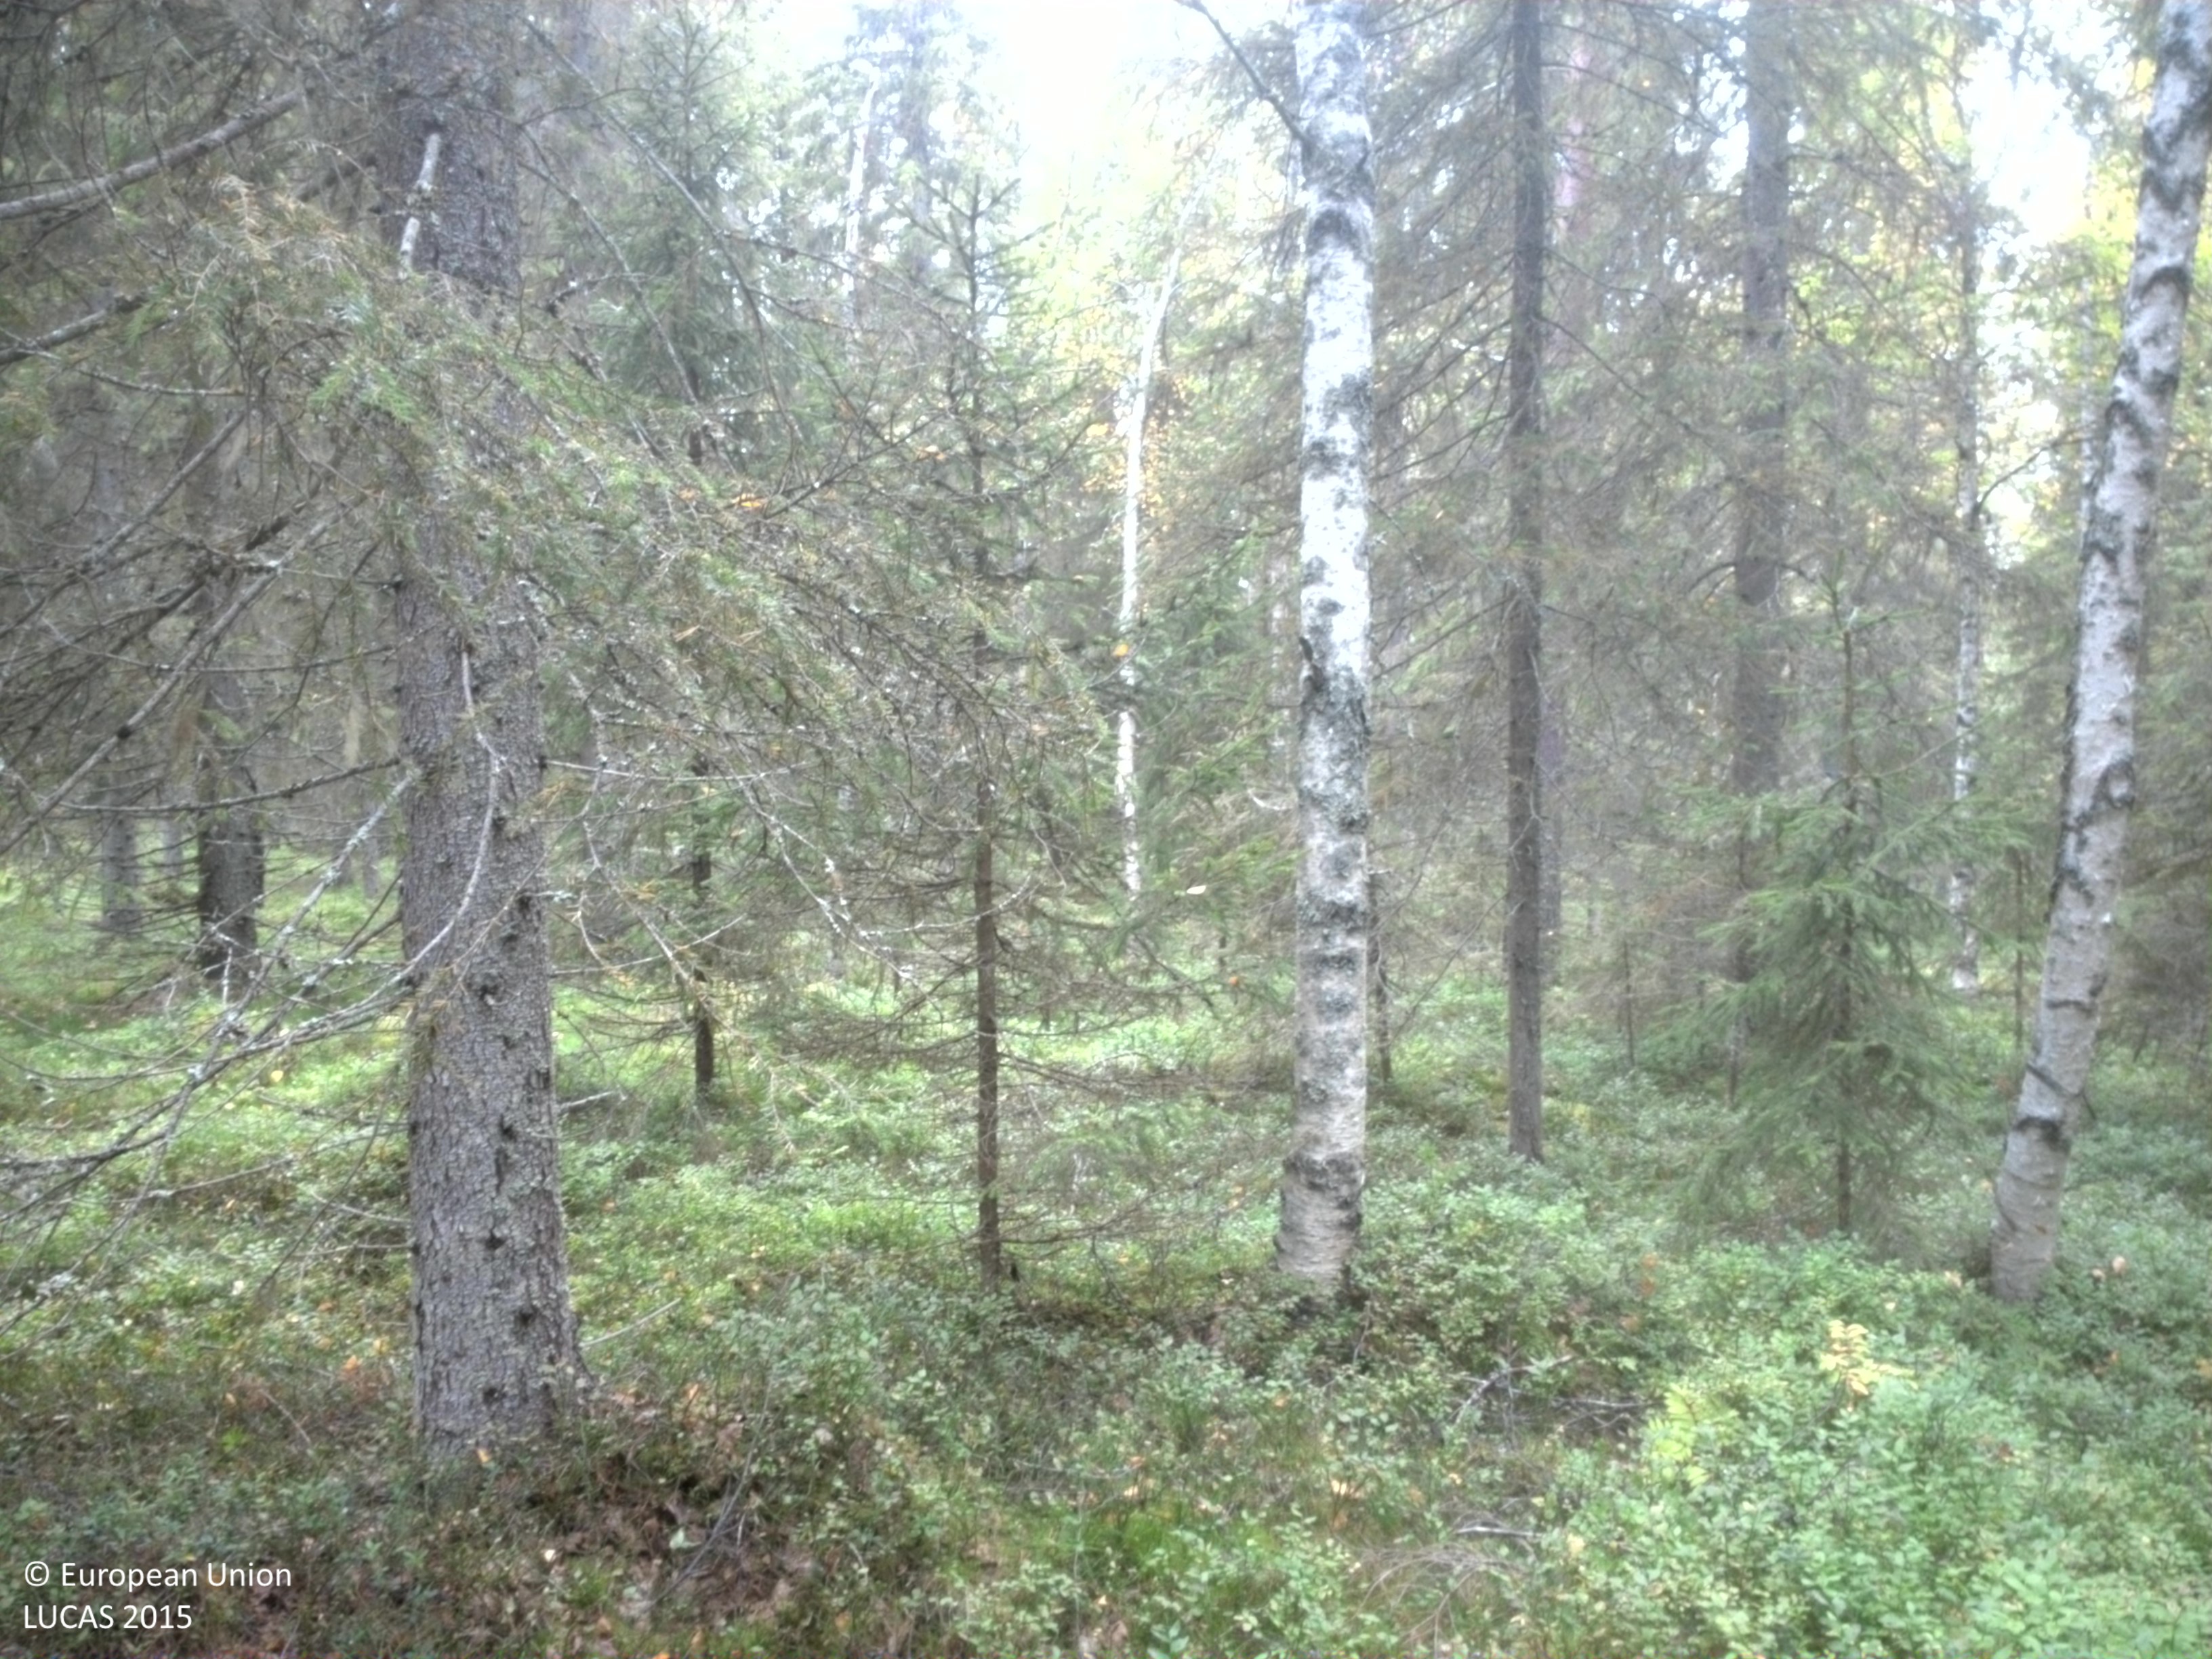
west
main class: Woodland
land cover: Other mixed woodland
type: boreal forest
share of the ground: 50 - 75 %
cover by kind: coniferous forest trees 45 %, shrubs 30 %, broadleaved forest trees 20 %, lichens and mosses 5 %
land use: Forestry
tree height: > 5 m
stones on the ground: 10 - 25 %
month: September
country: SE
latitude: 64.4659
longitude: 20.2683
